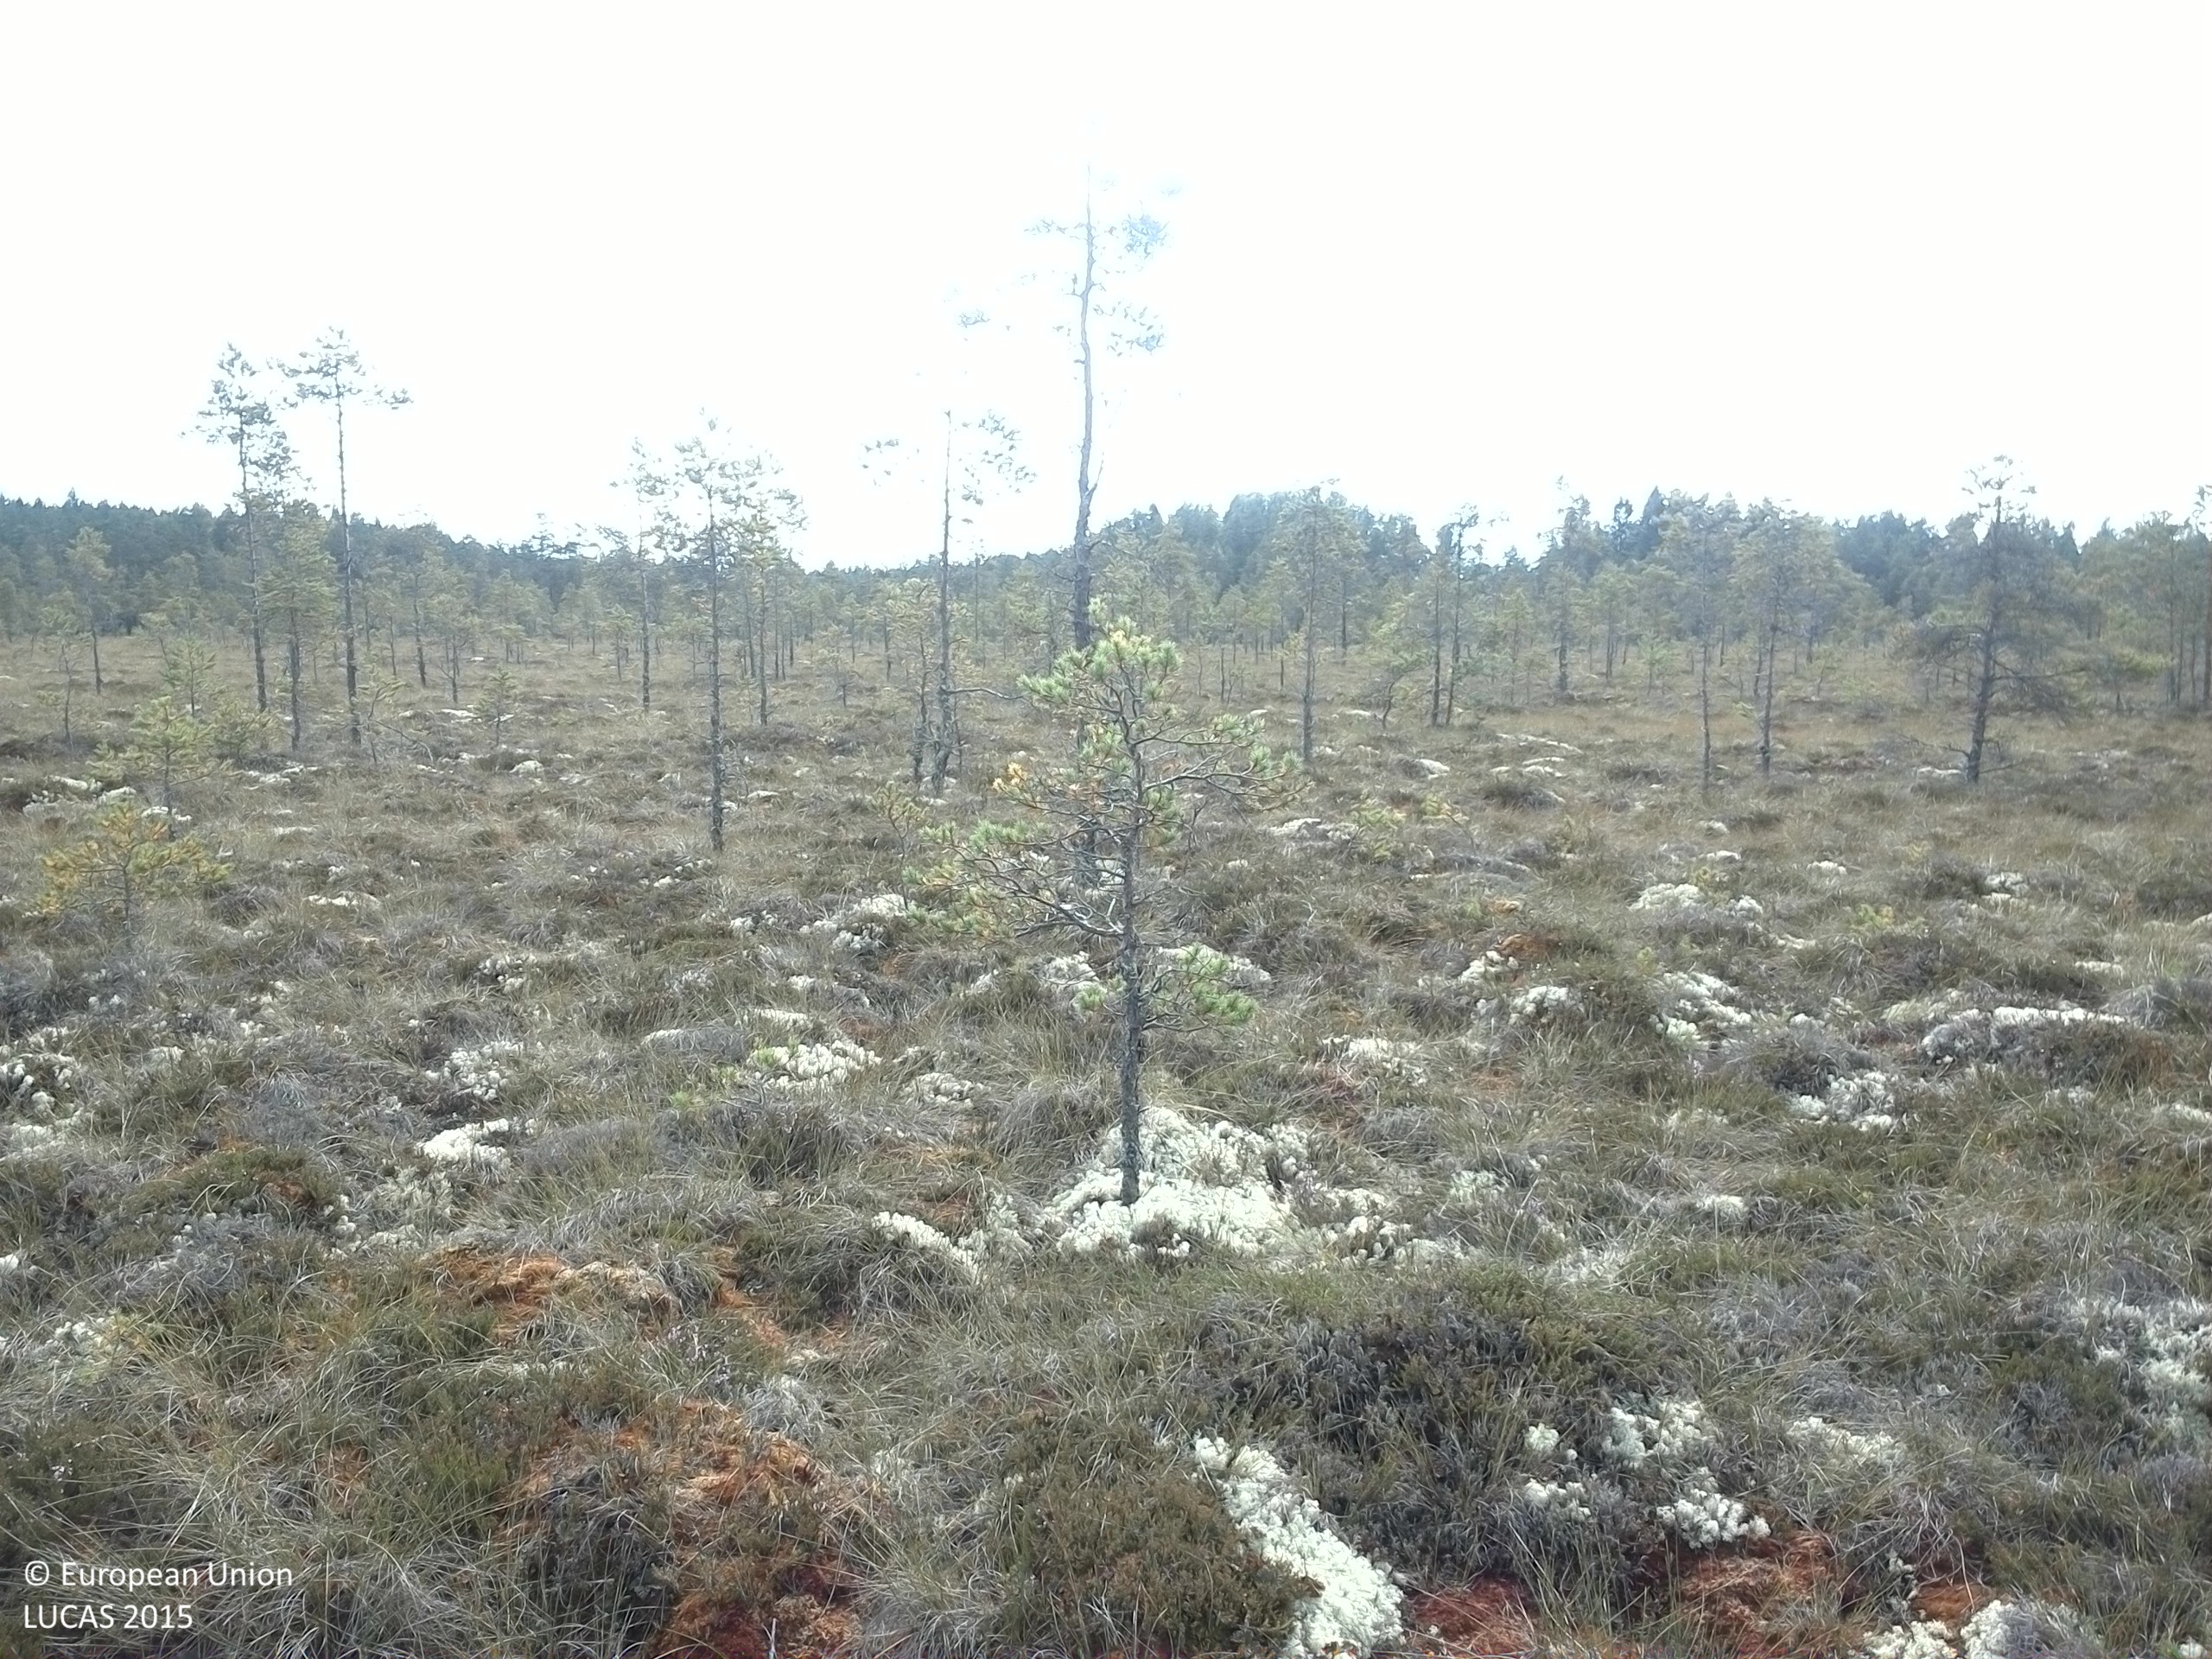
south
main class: Woodland
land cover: Pine dominated coniferous woodland
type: boreal forest
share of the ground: 10 - 25 %
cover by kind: shrubs 35 %, lichens and mosses 35 %, herbaceous plants 20 %, coniferous forest trees 10 %
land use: Semi-natural and natural areas not in use
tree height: < 5 m
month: September
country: SE
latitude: 59.9455
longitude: 13.2314
